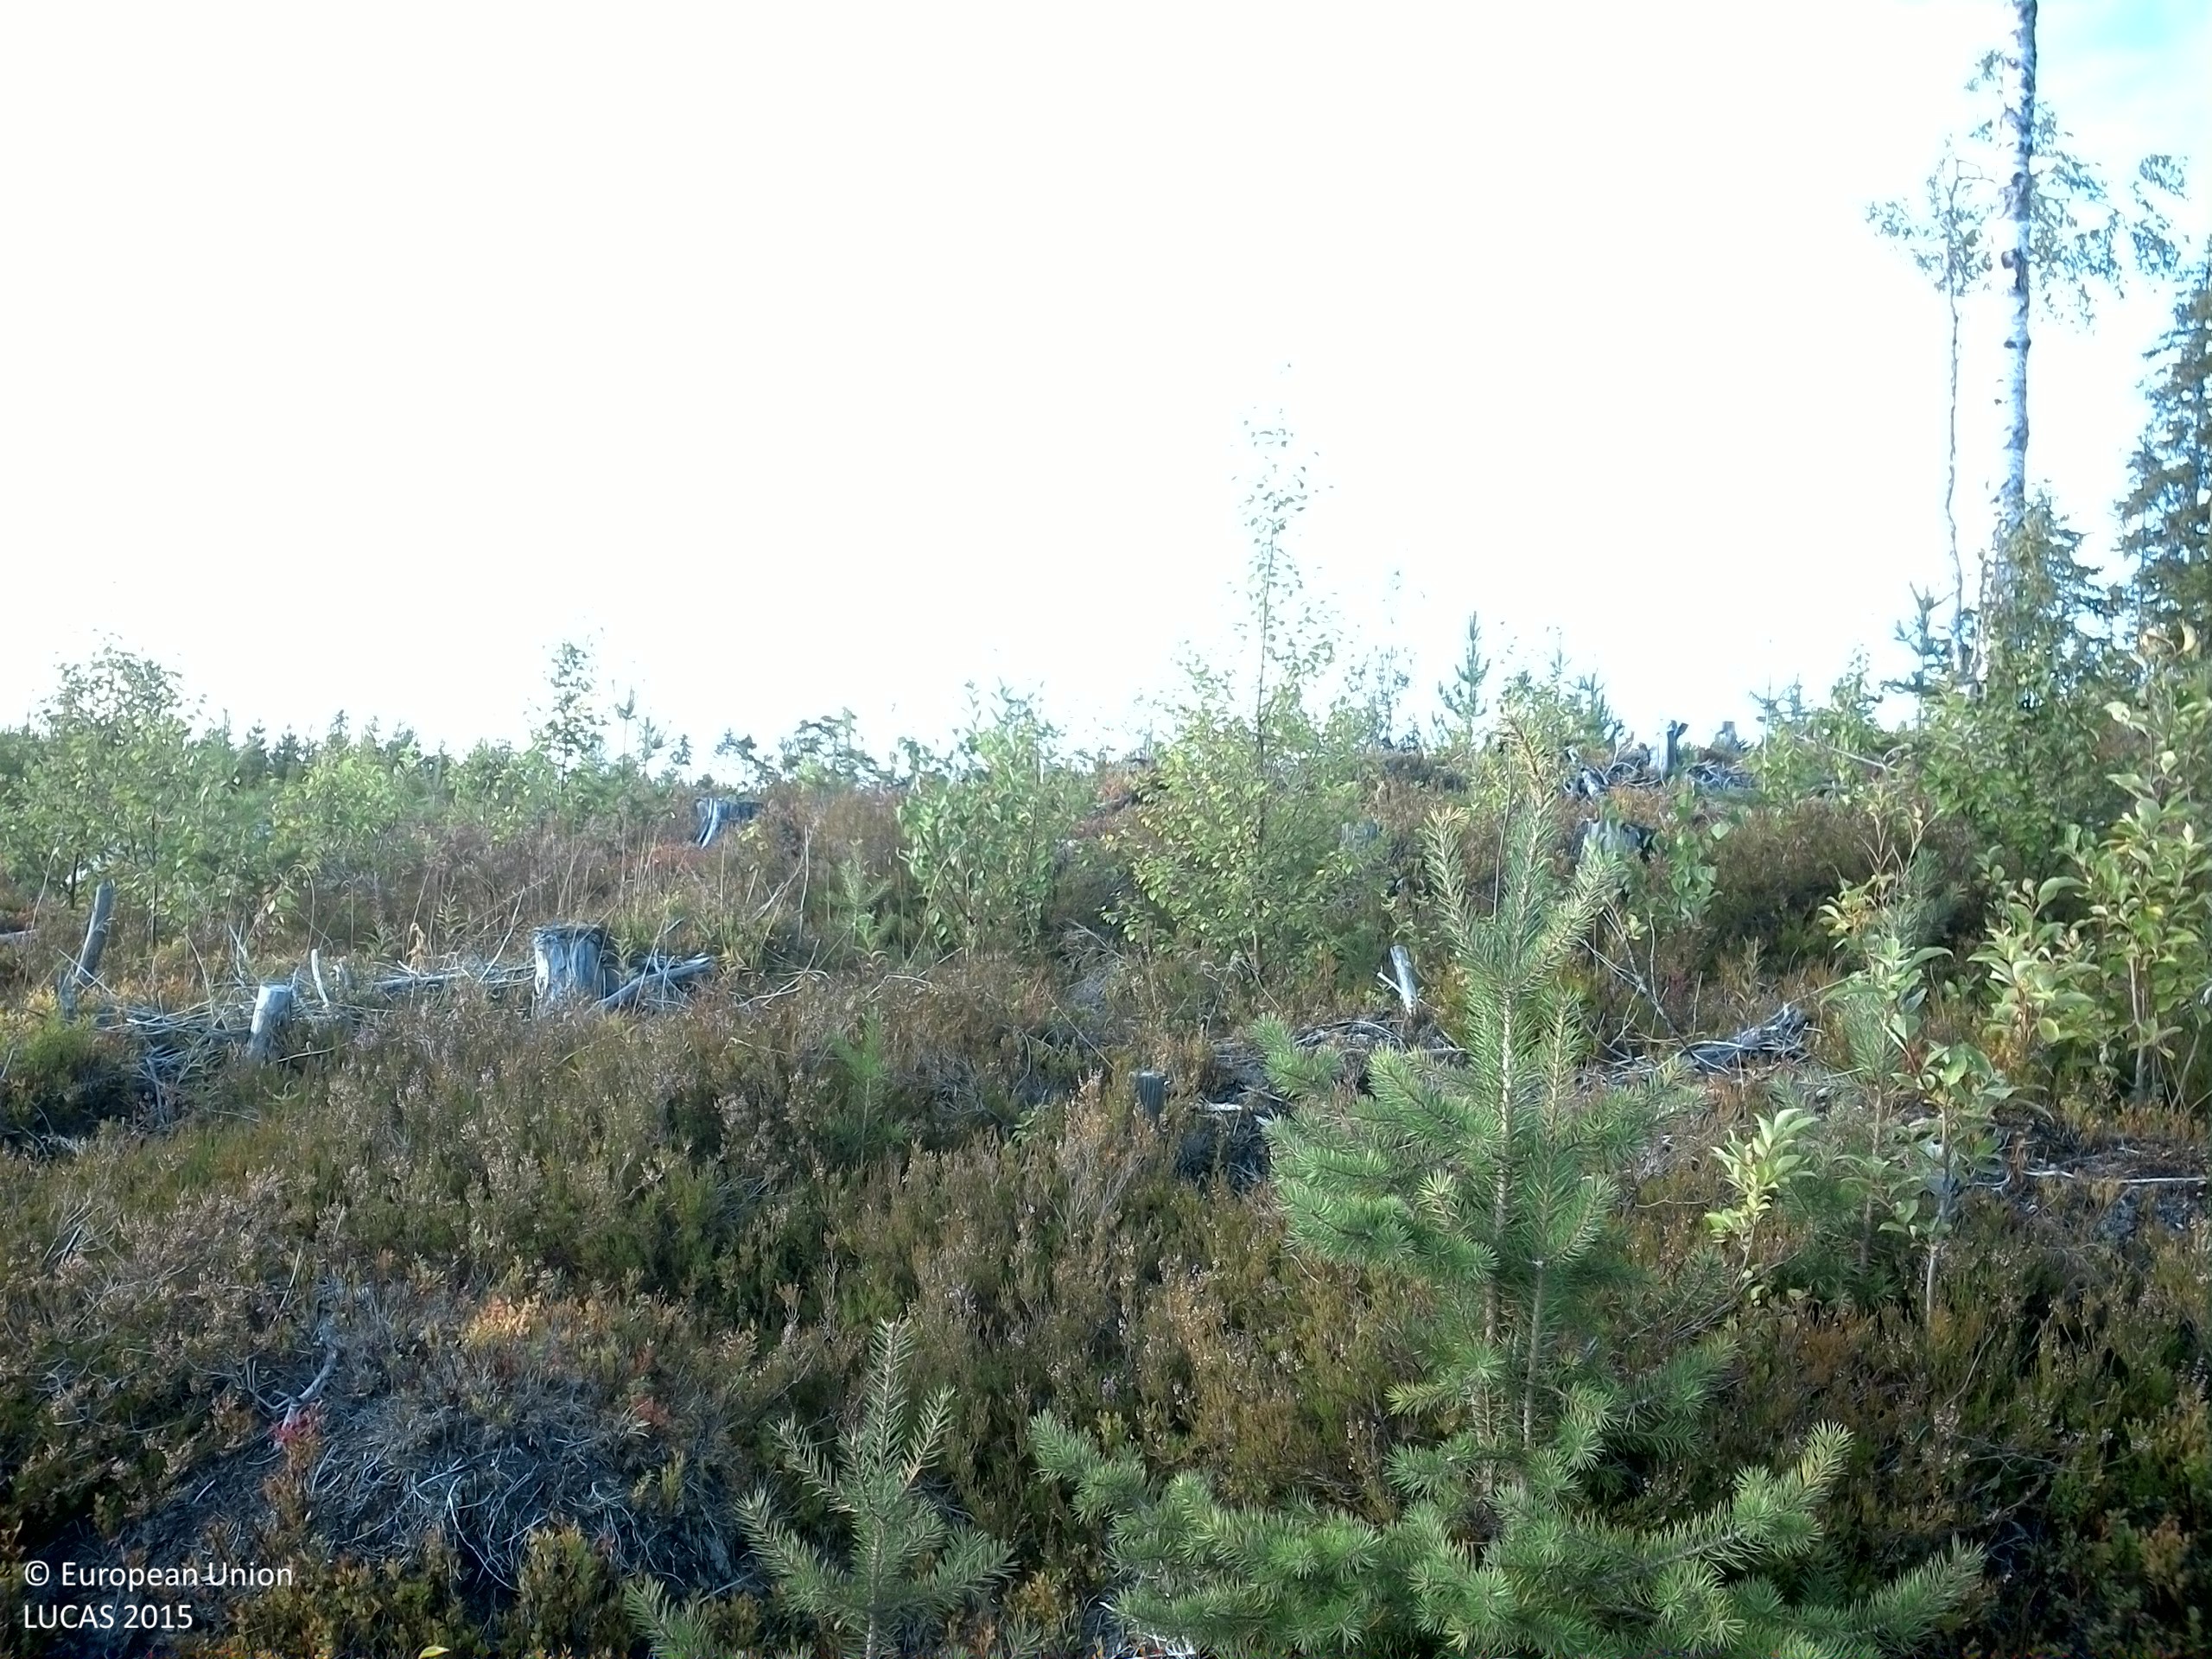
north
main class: Woodland
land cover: Spruce dominated mixed woodland
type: boreal forest
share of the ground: 10 - 25 %
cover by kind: shrubs 45 %, lichens and mosses 25 %, broadleaved forest trees 15 %, coniferous forest trees 10 %, herbaceous plants 5 %
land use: Forestry
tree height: < 5 m
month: August
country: SE
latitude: 64.0816
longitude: 17.3726
